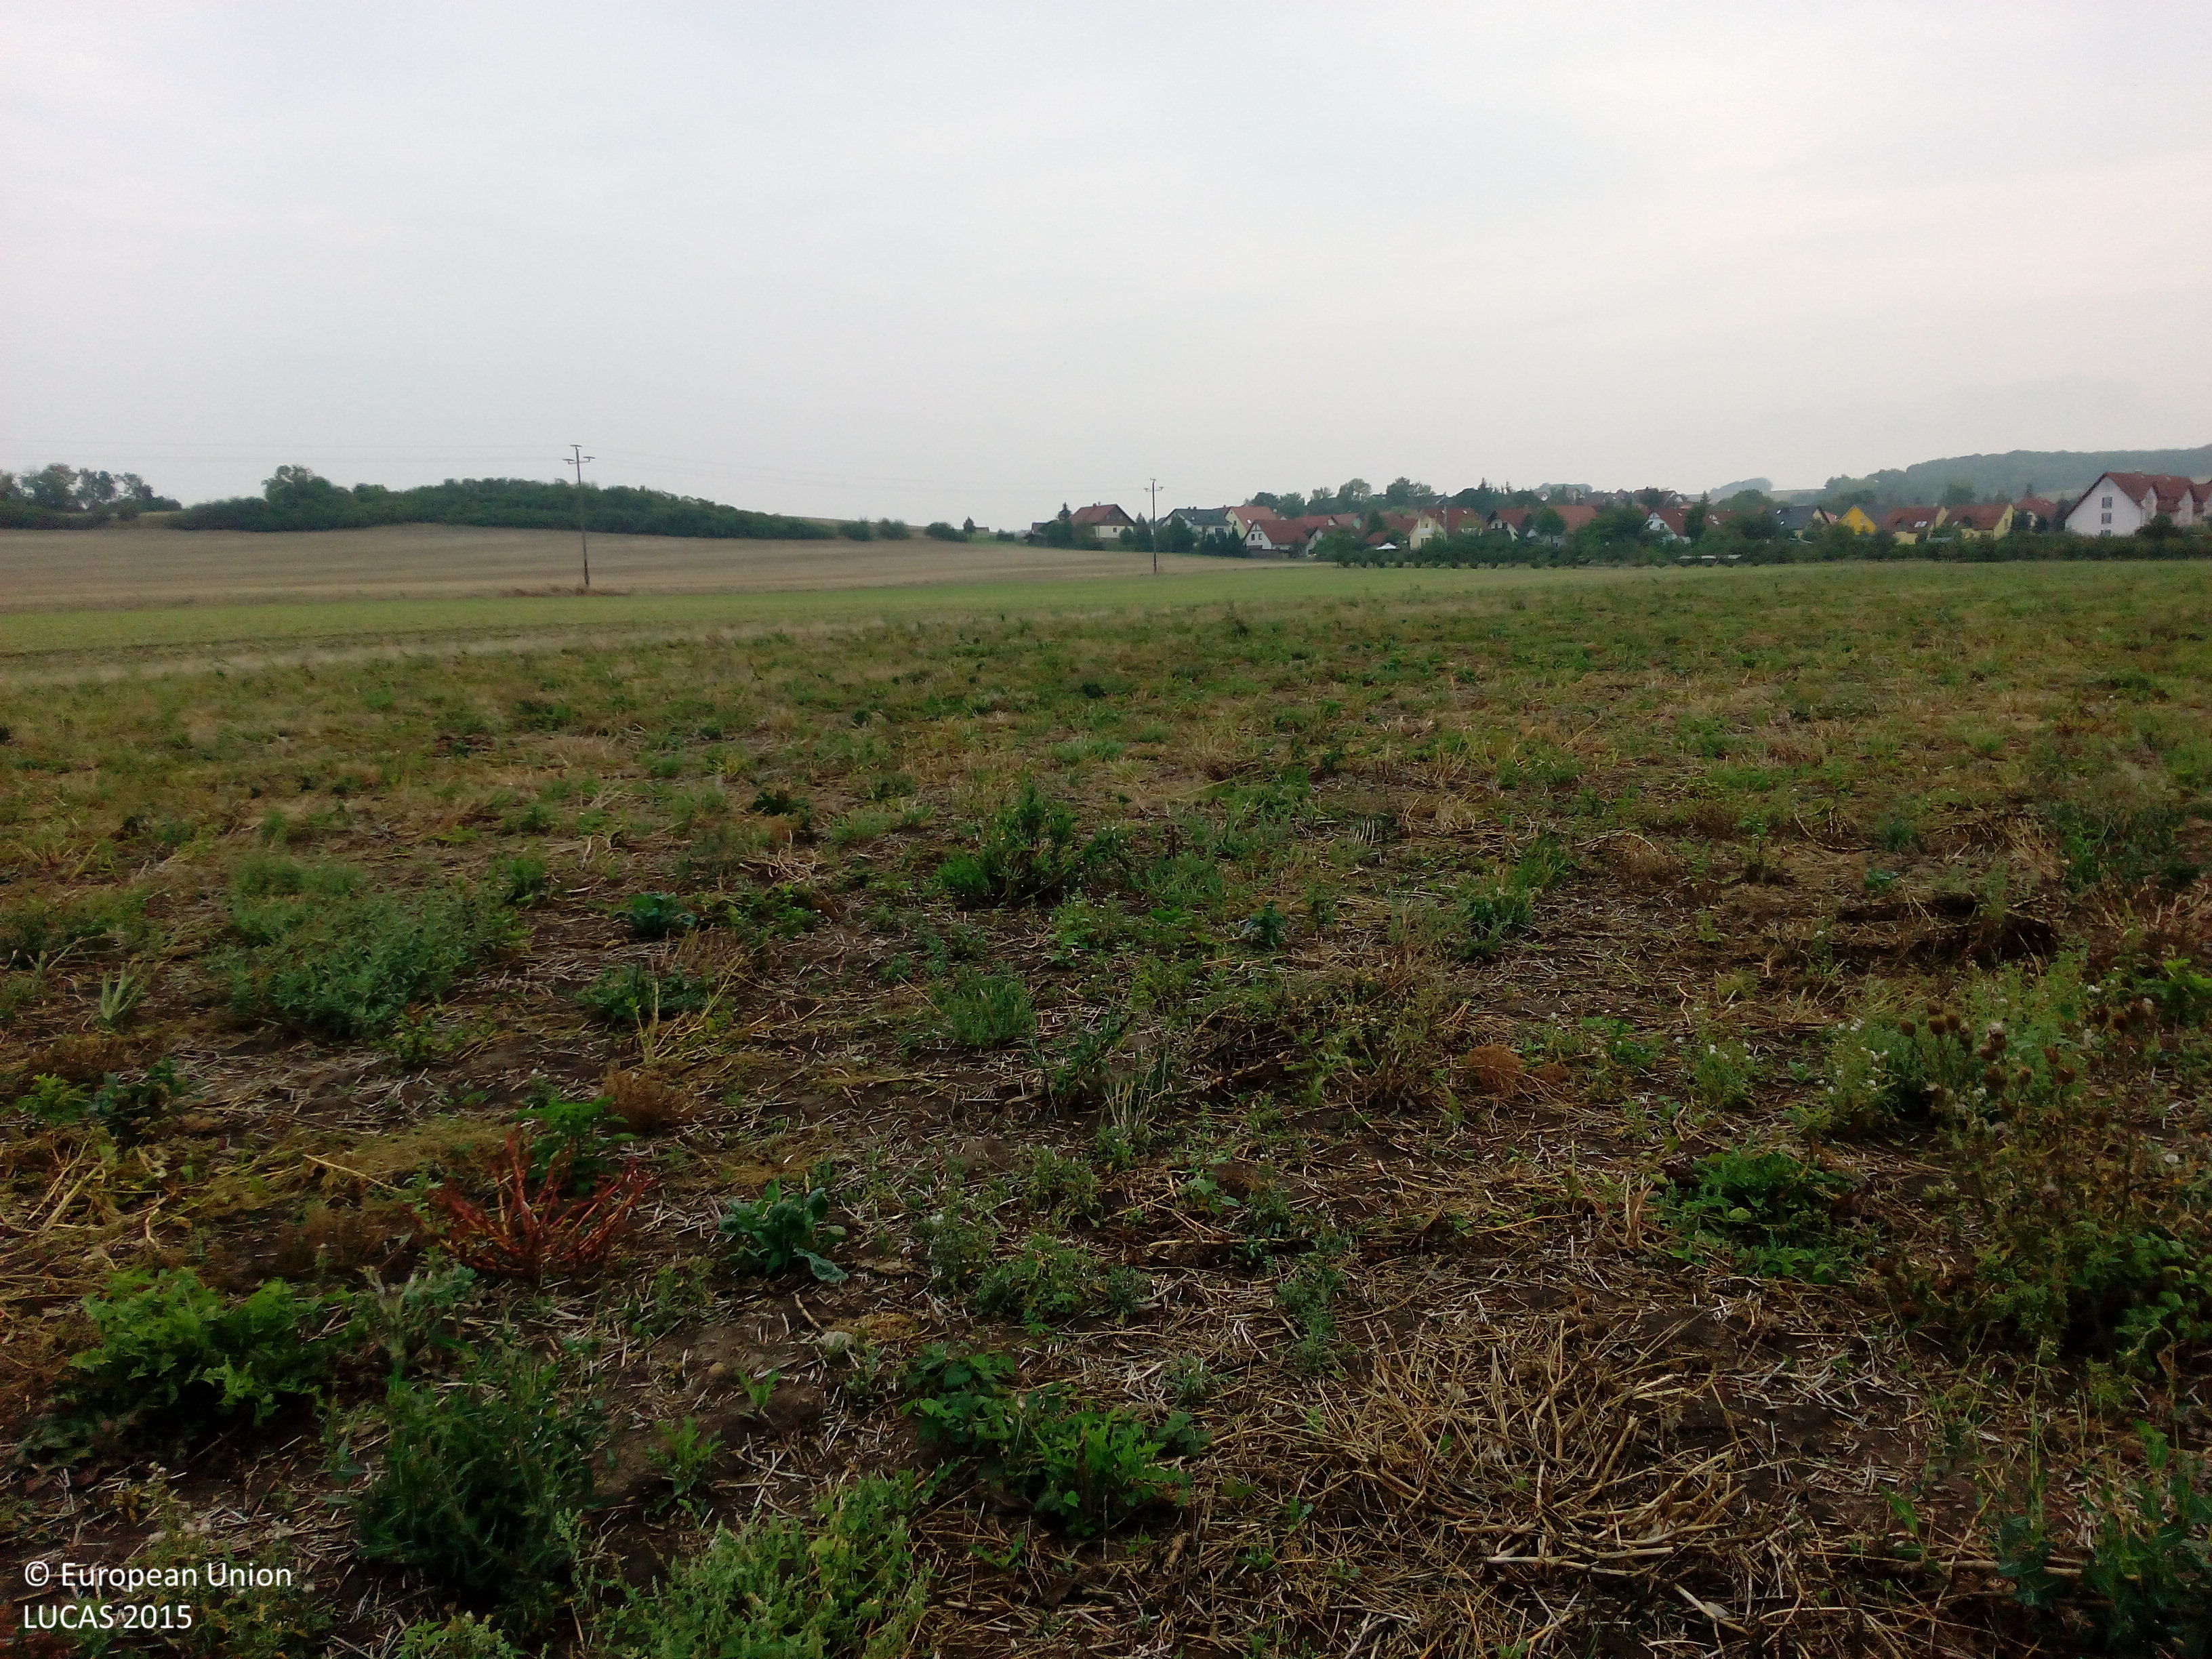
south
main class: Grassland
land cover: Spontaneously vegetated surfaces
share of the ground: 25 - 50 %
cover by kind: unconsolidated bare surface 60 %, herbaceous plants 40 %
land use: Fallow land
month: August
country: DE
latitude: 51.0254
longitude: 10.9550
